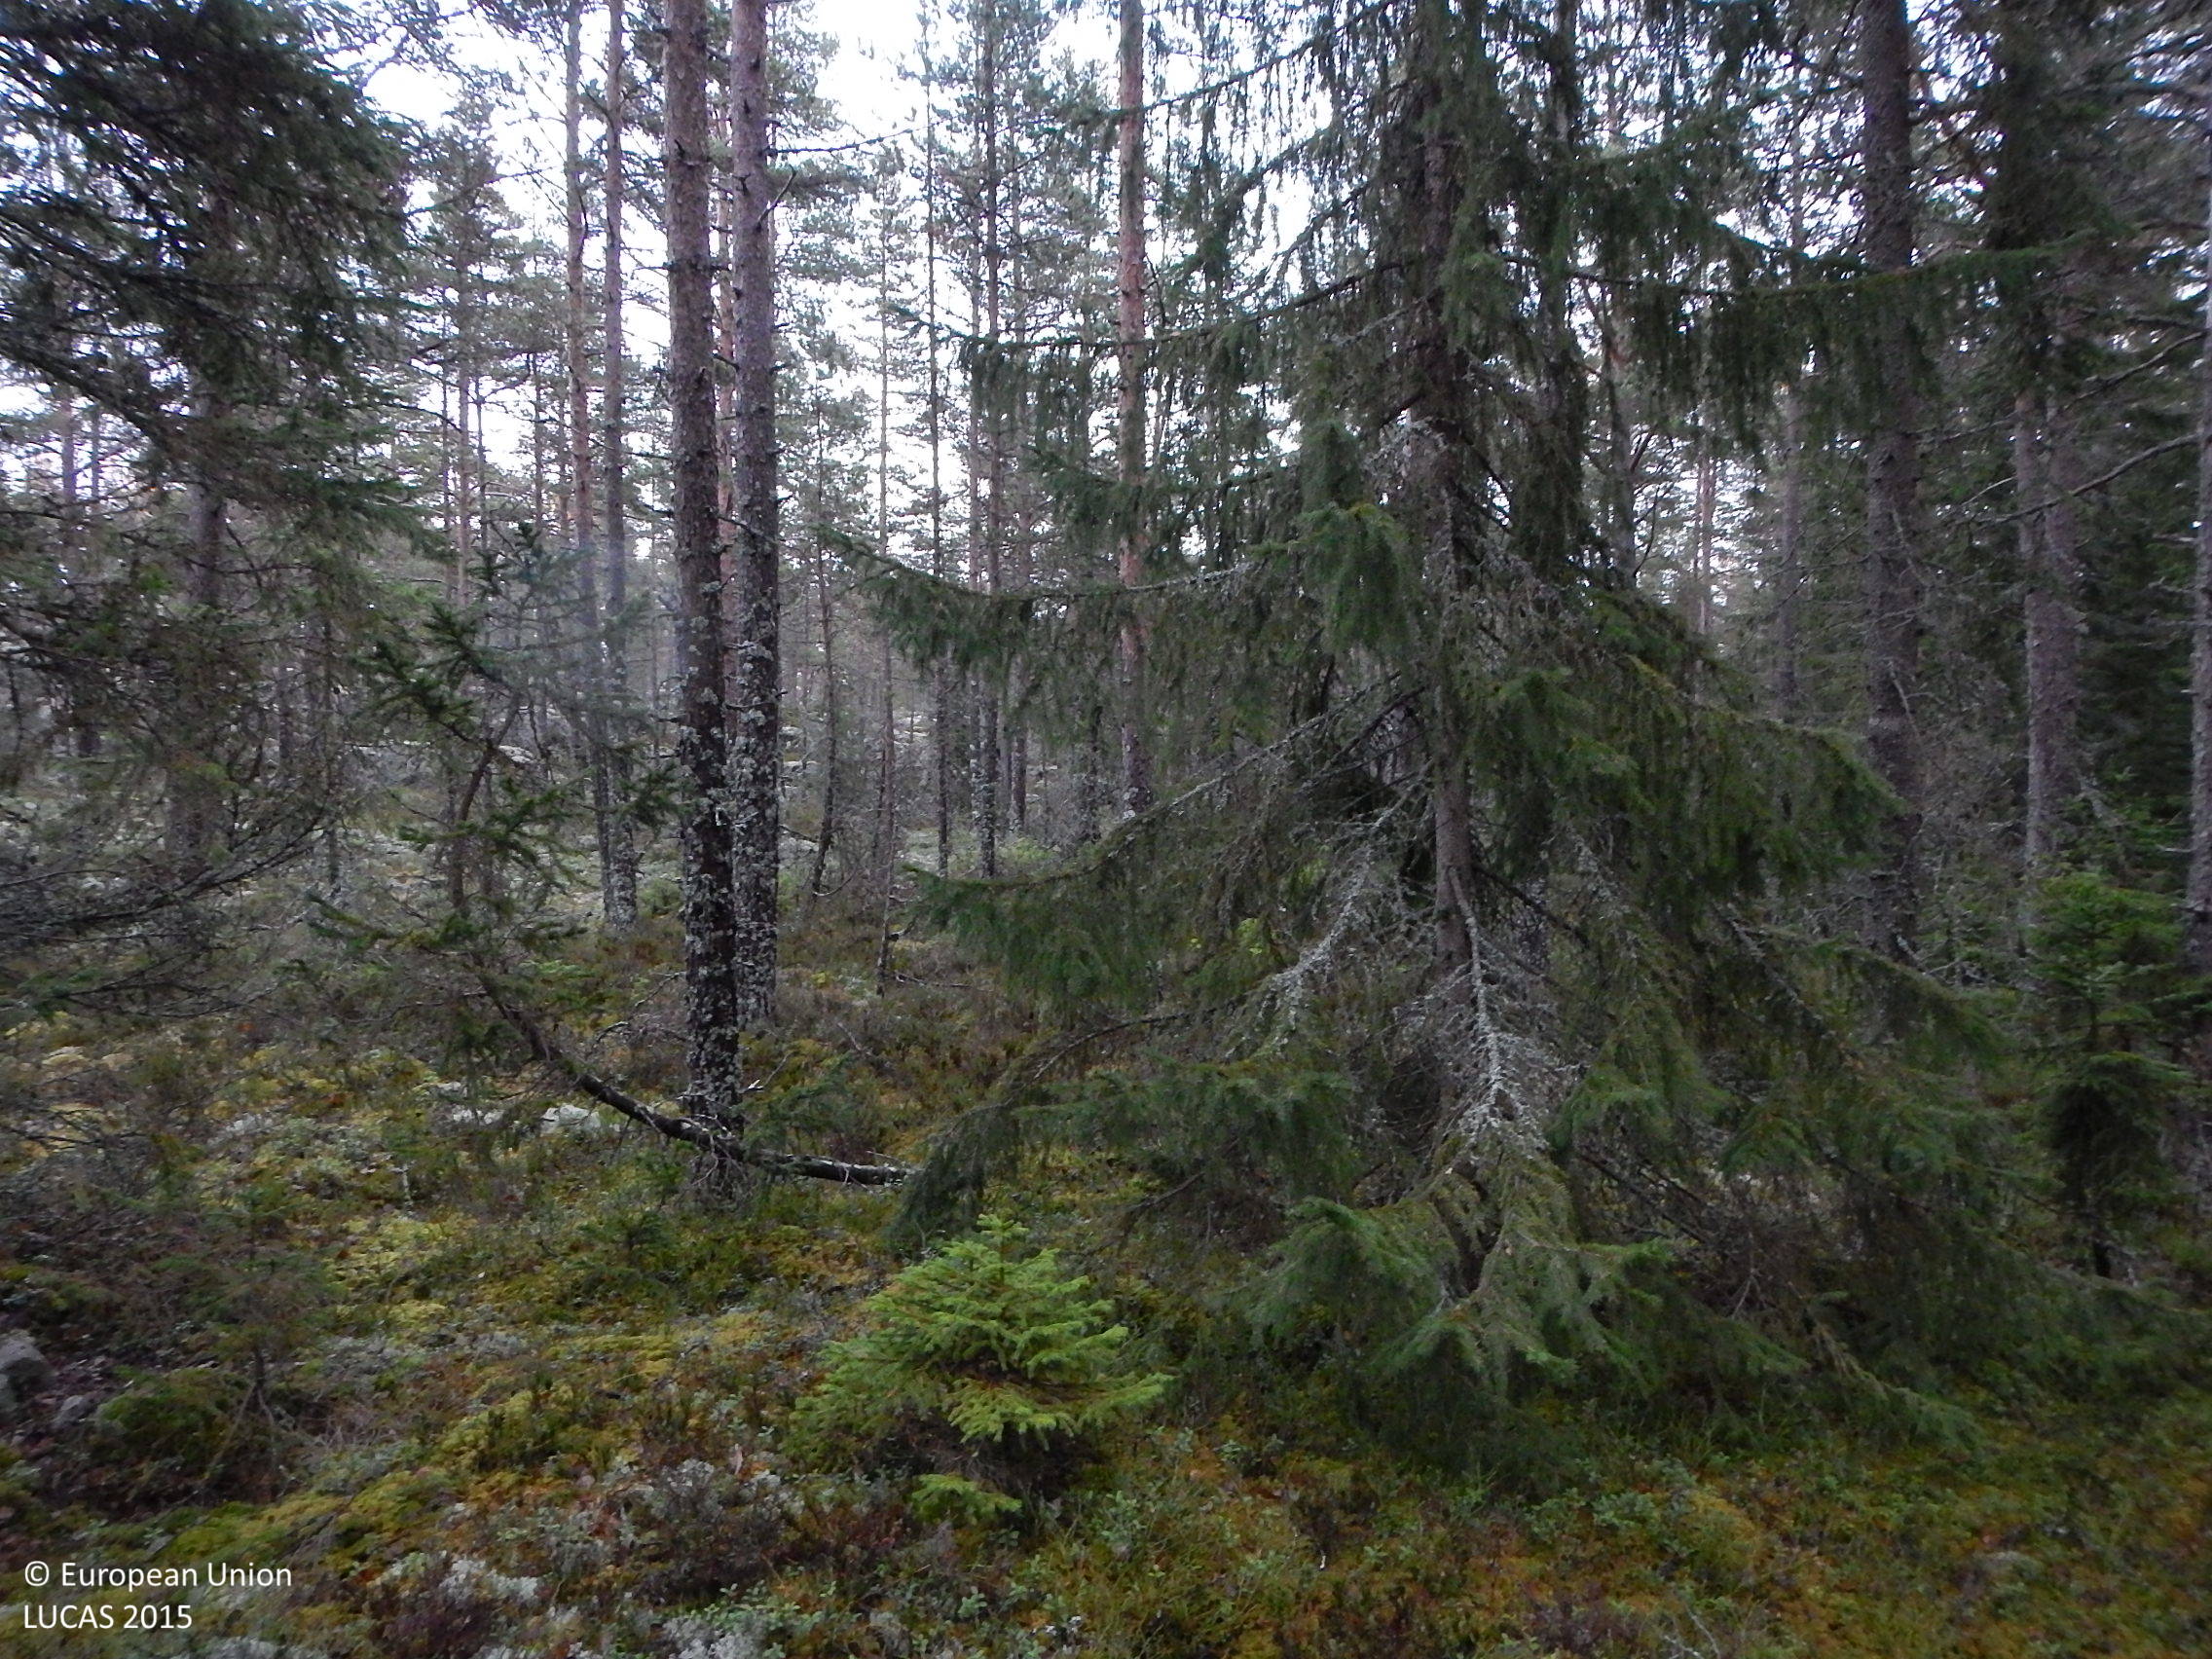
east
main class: Woodland
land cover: Pine dominated coniferous woodland
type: boreal forest
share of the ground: 50 - 75 %
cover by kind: coniferous forest trees 70 %, shrubs 20 %, lichens and mosses 10 %
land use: Semi-natural and natural areas not in use
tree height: > 5 m
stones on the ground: < 10 %
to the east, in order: Pine dominated coniferous woodland
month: November
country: SE
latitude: 61.6295
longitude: 17.4746
